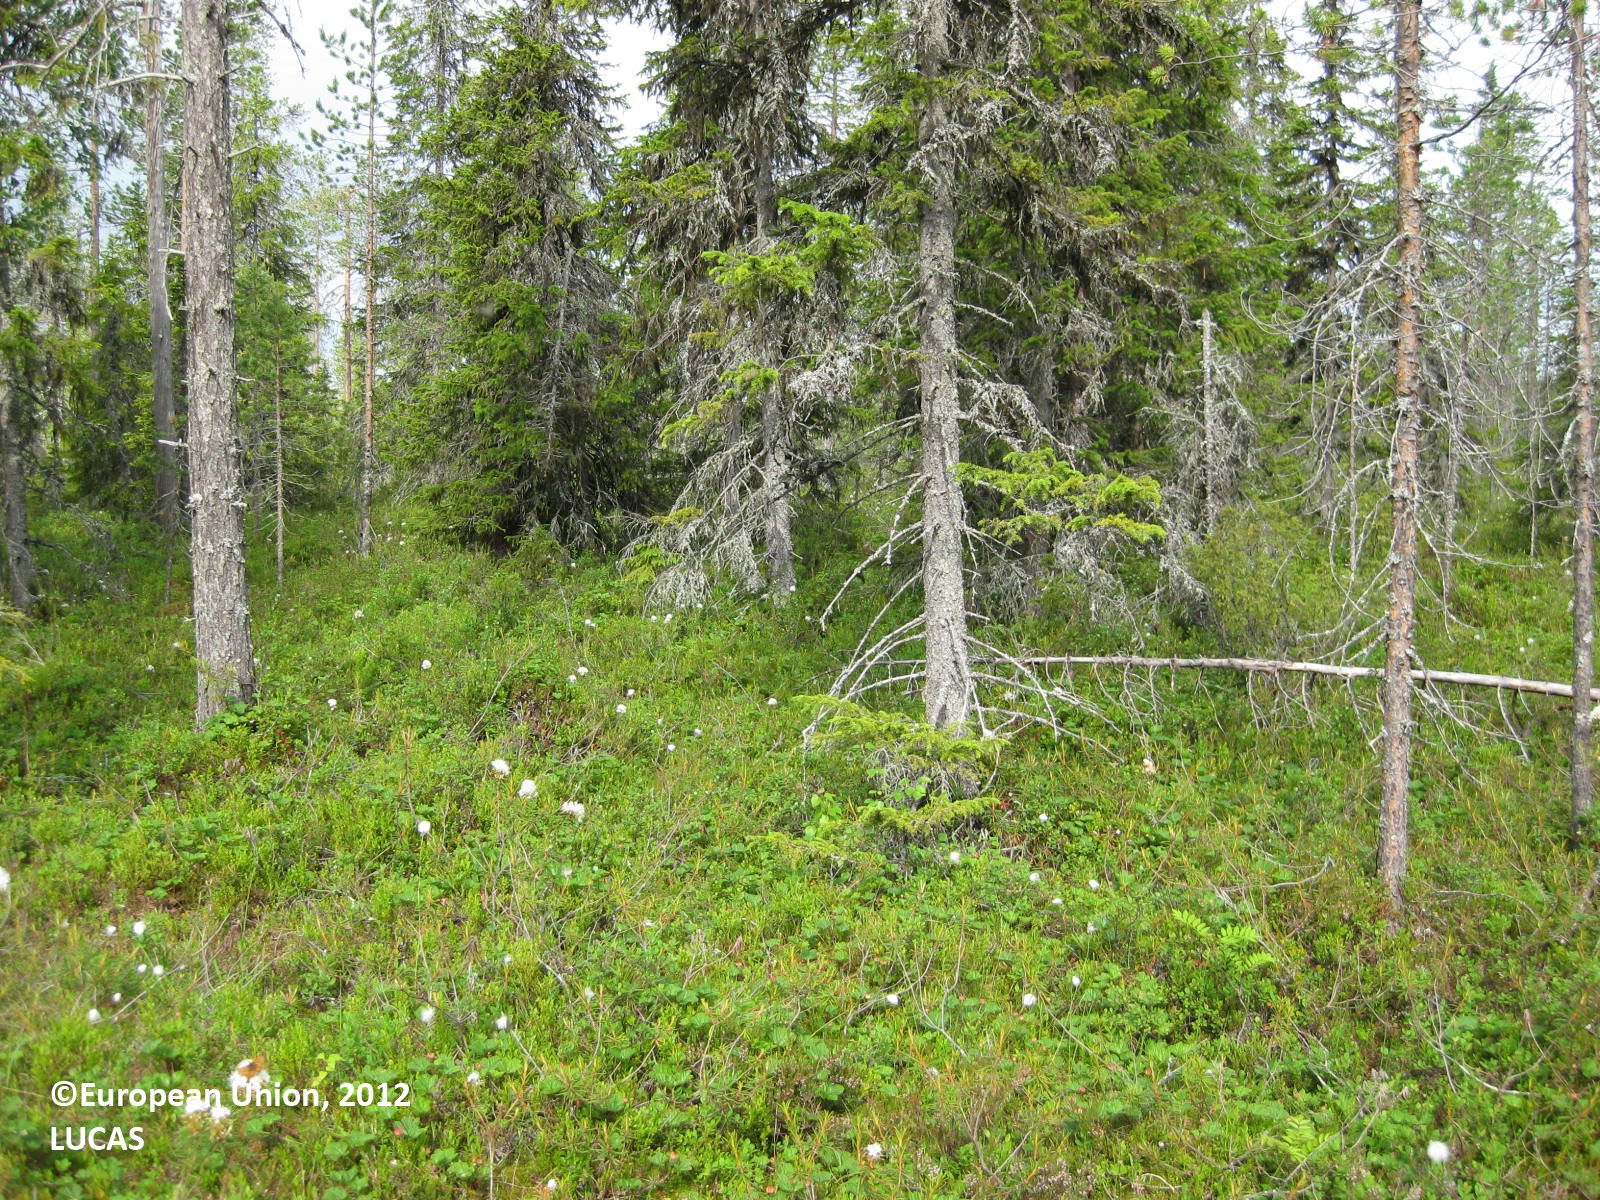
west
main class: Woodland
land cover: Other coniferous woodland
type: mire and swamp forests
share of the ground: 25 - 50 %
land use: Forestry
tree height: > 5 m
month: July
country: FI
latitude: 65.5865
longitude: 29.2015
